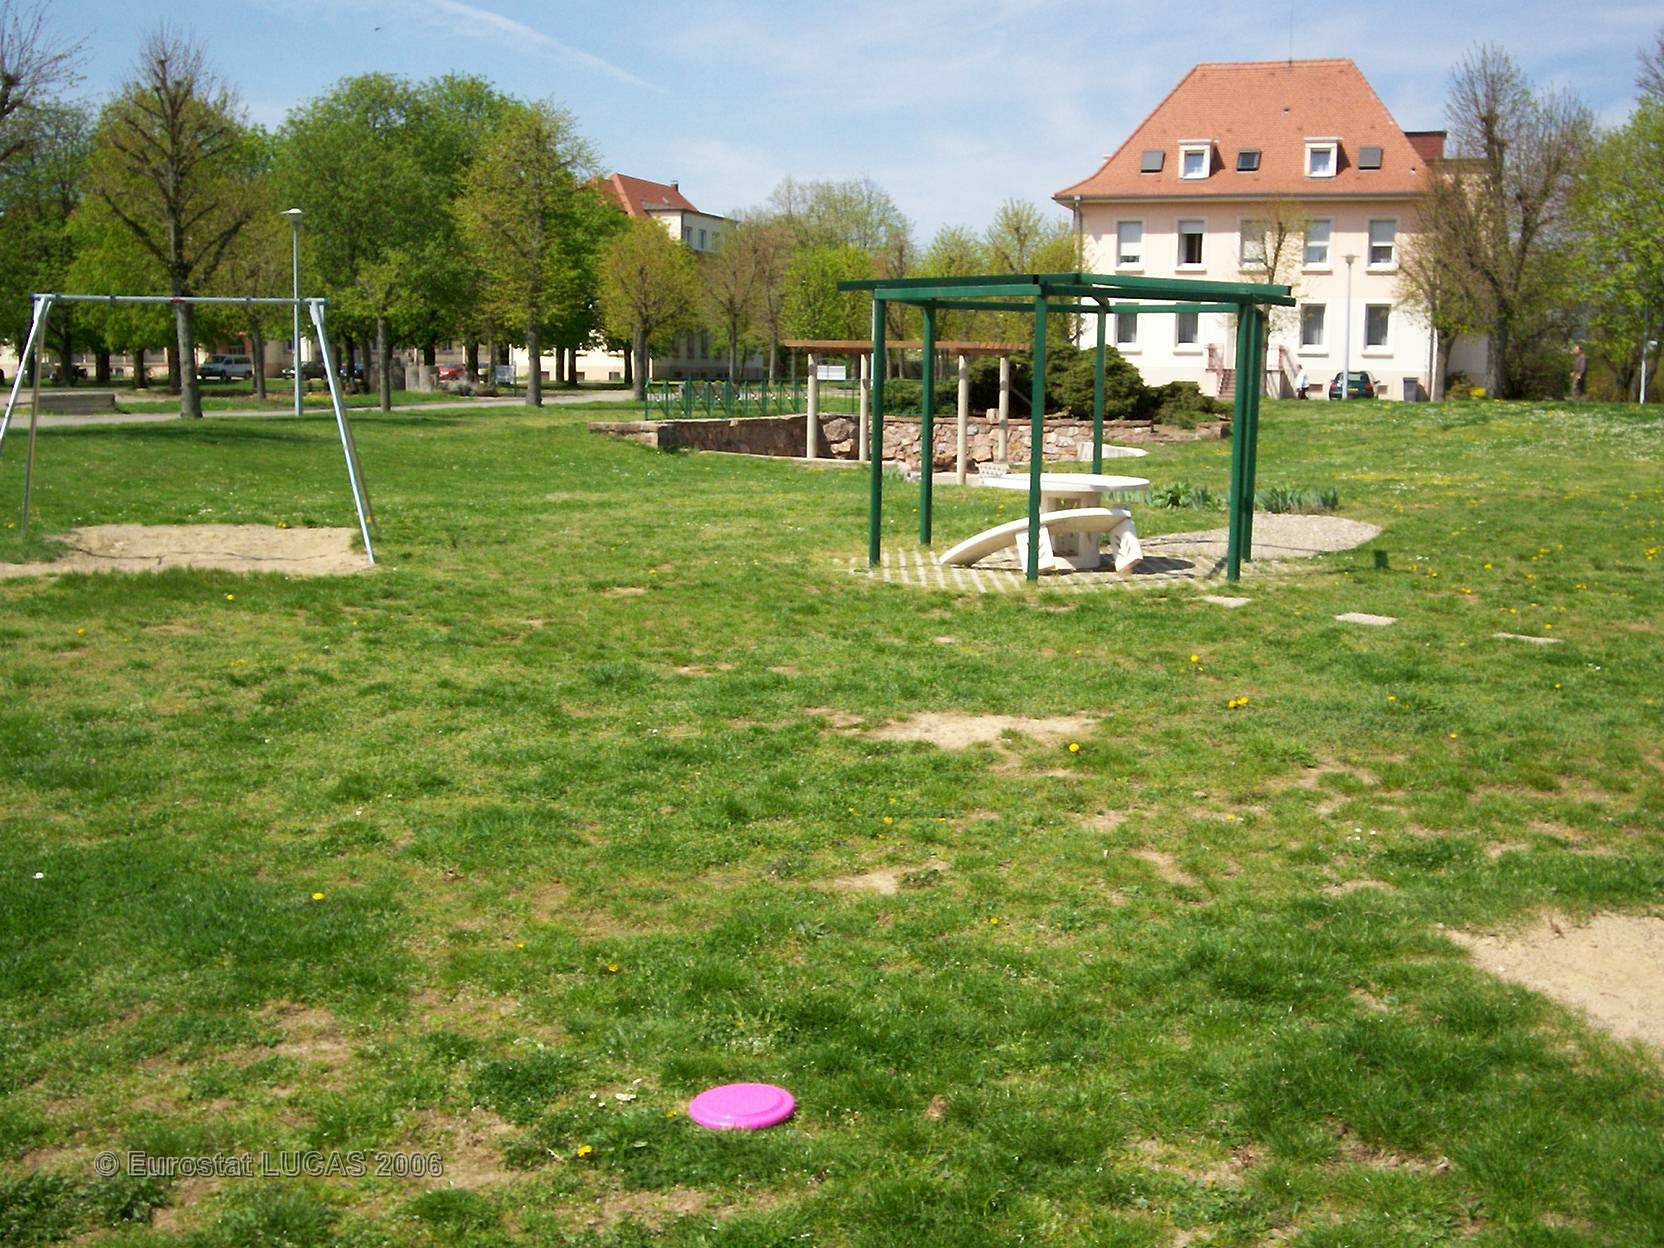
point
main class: Grassland
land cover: Grassland without tree/shrub cover
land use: Amenities, museums, leisure
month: April
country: FR
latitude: 47.7908
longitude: 7.1581
